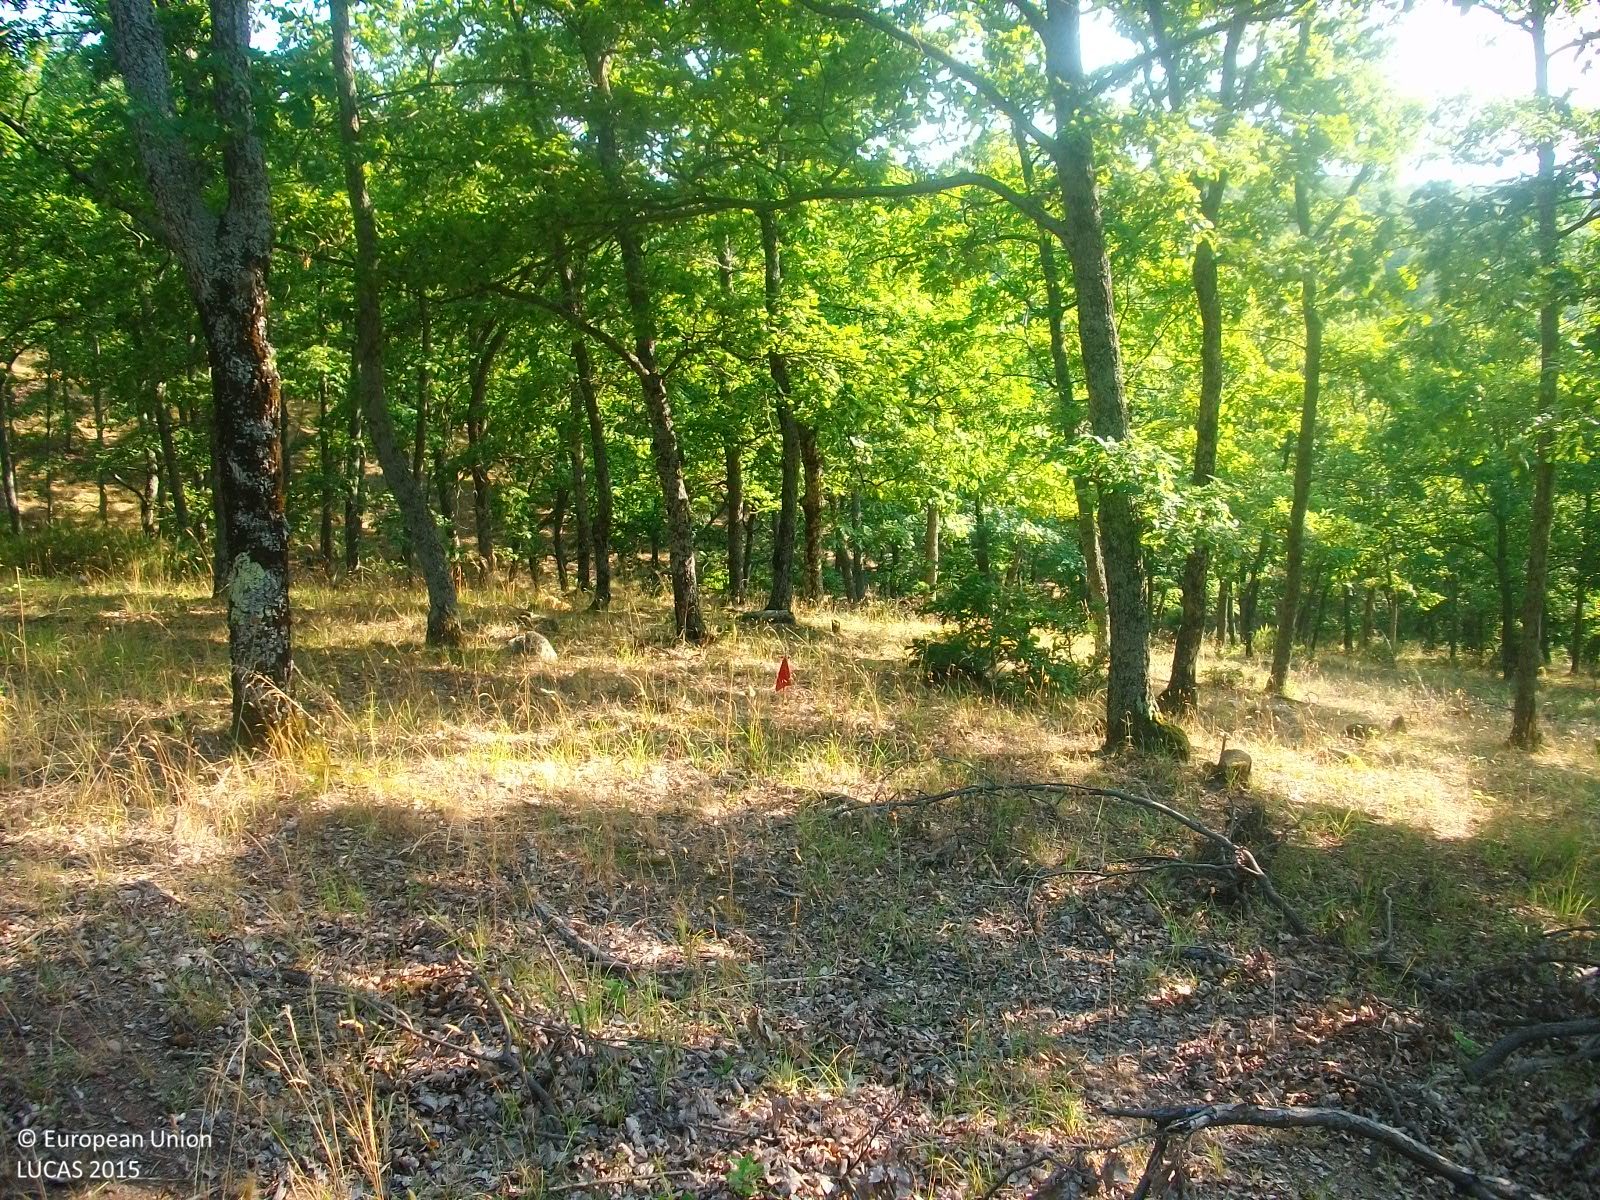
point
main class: Woodland
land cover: Broadleaved woodland
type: thermophilous deciduous forest
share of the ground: > 75 %
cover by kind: broadleaved forest trees 100 %
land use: Forestry
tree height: > 5 m
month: August
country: GR
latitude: 41.2609
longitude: 26.1205
